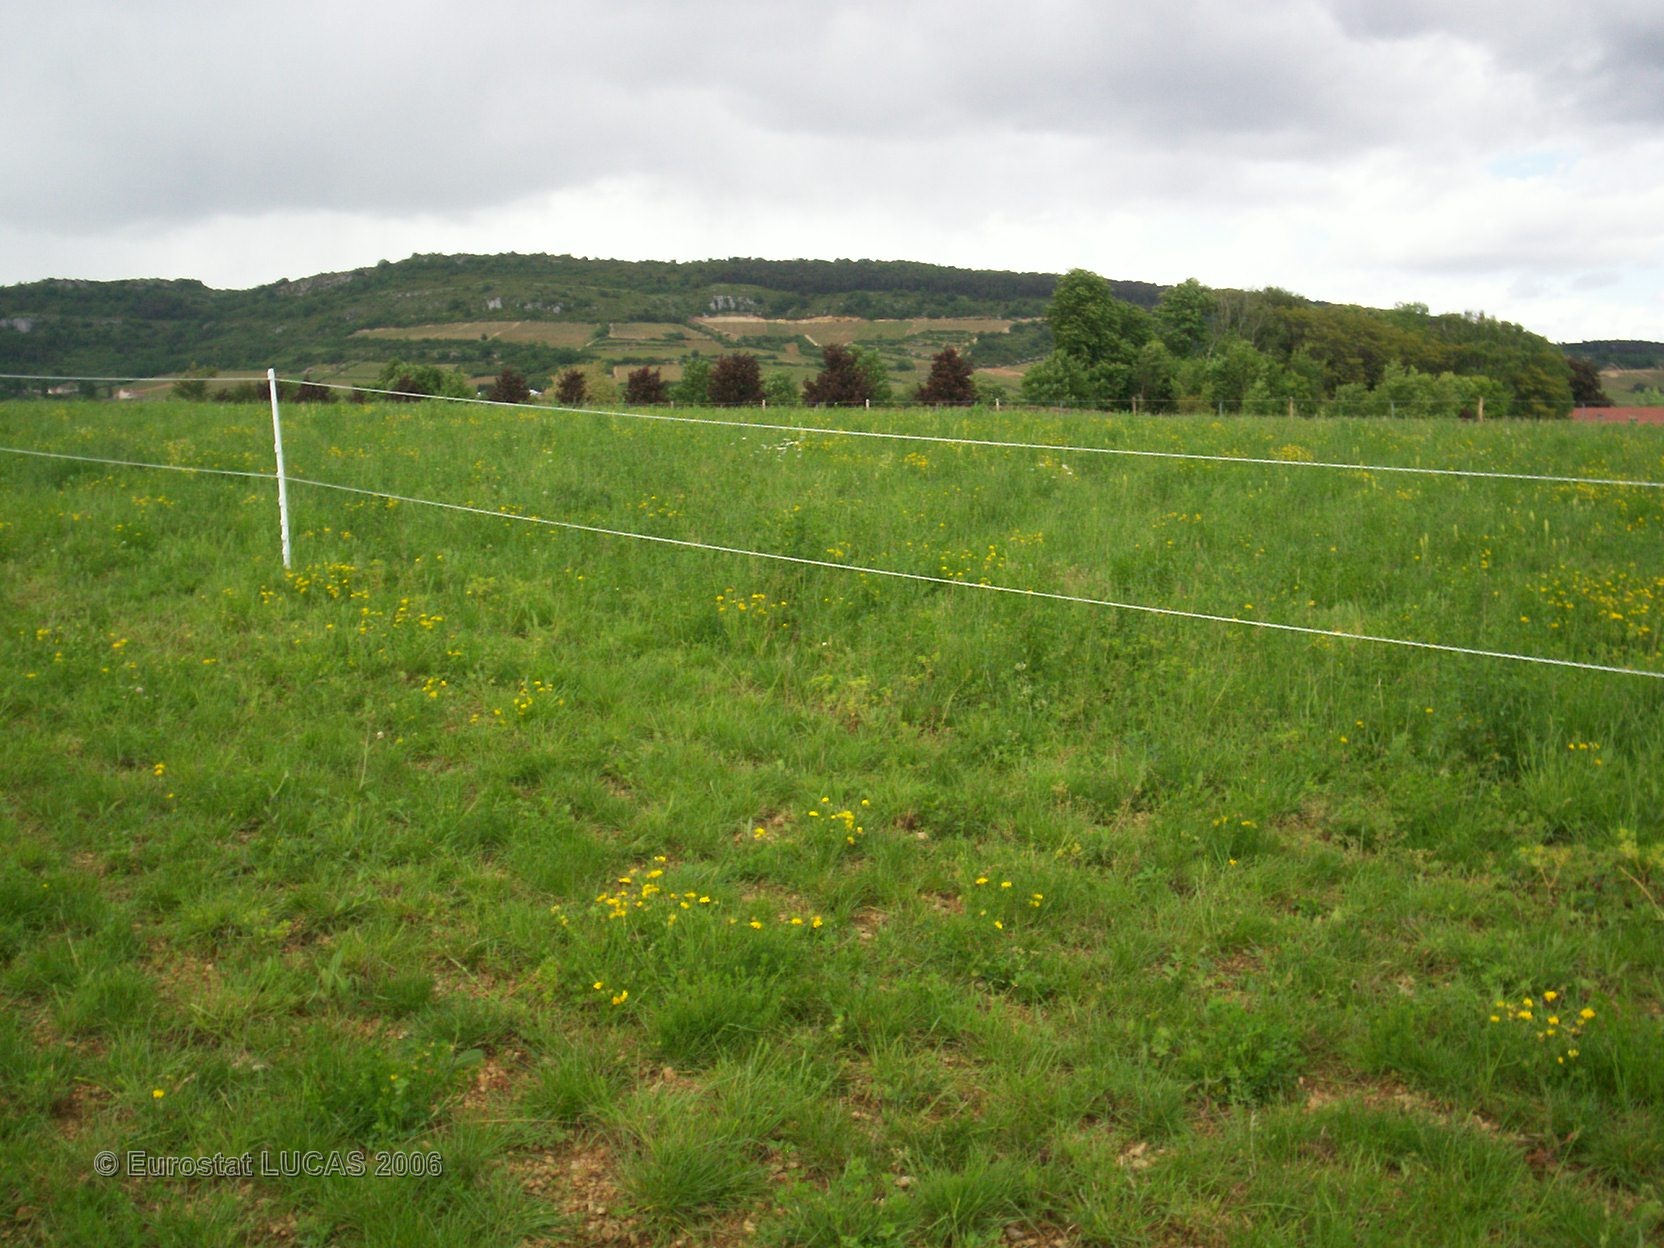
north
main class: Grassland
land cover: Grassland without tree/shrub cover
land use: Agriculture (excluding fallow land and kitchen gardens)
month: May
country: FR
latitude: 46.9048
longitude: 4.6839
